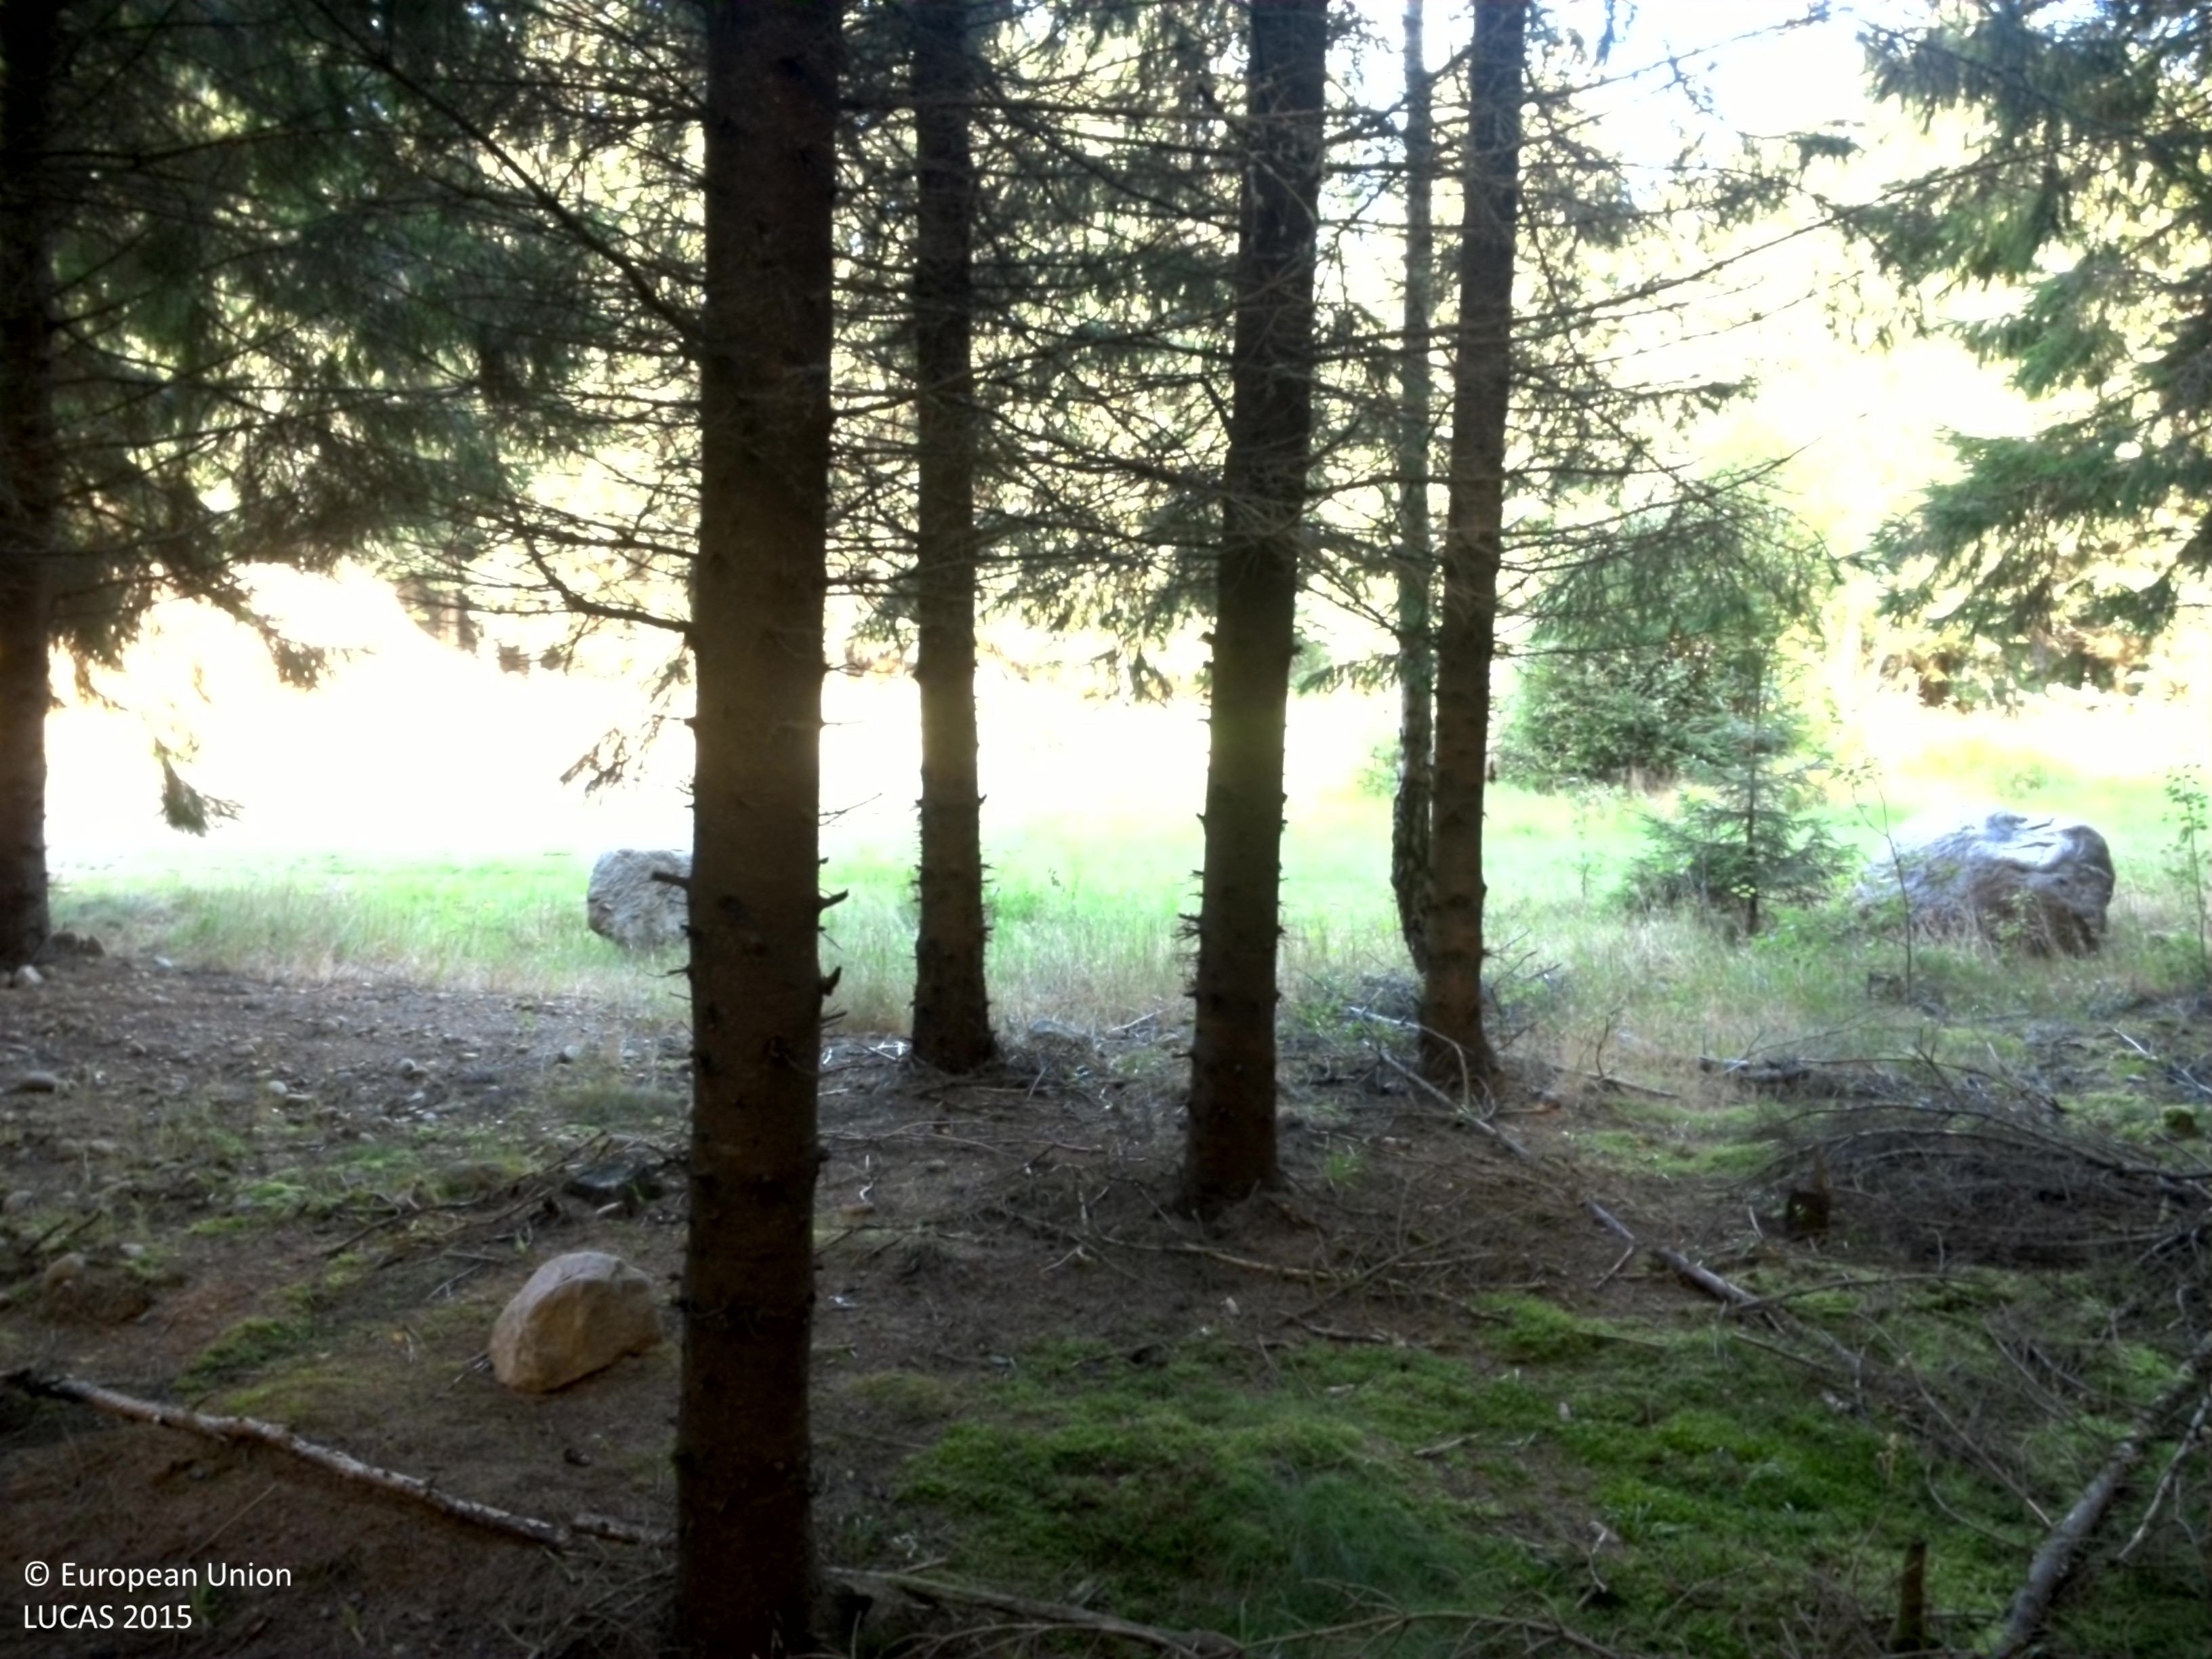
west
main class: Woodland
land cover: Spruce dominated coniferous woodland
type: boreal forest
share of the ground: > 75 %
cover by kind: coniferous forest trees 90 %, lichens and mosses 5 %, unconsolidated bare surface 5 %
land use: Forestry
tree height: > 5 m
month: August
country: SE
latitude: 58.1779
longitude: 13.3443
